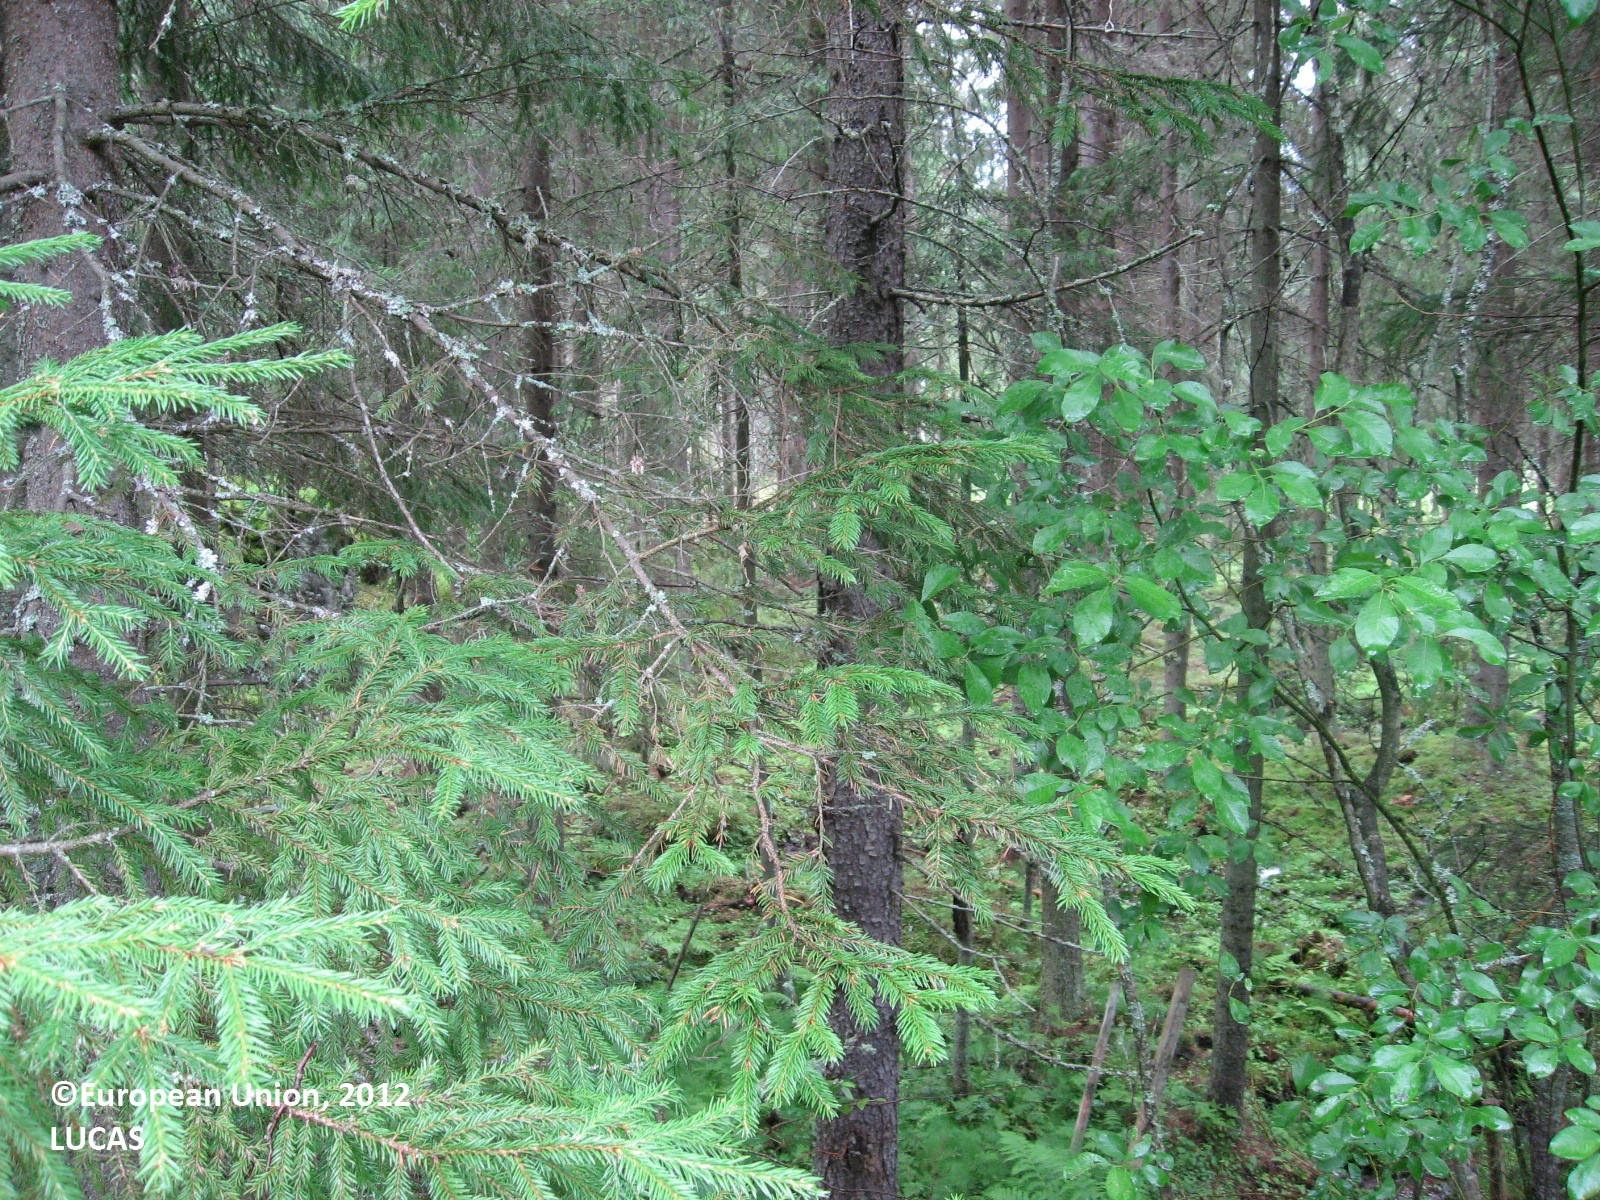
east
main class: Woodland
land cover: Spruce dominated coniferous woodland
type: boreal forest
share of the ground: > 75 %
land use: Forestry
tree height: > 5 m
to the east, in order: Spruce dominated coniferous woodland; Fences; Spruce dominated coniferous woodland; Spruce dominated mixed woodland
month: July
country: FI
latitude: 61.3091
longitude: 25.7964
